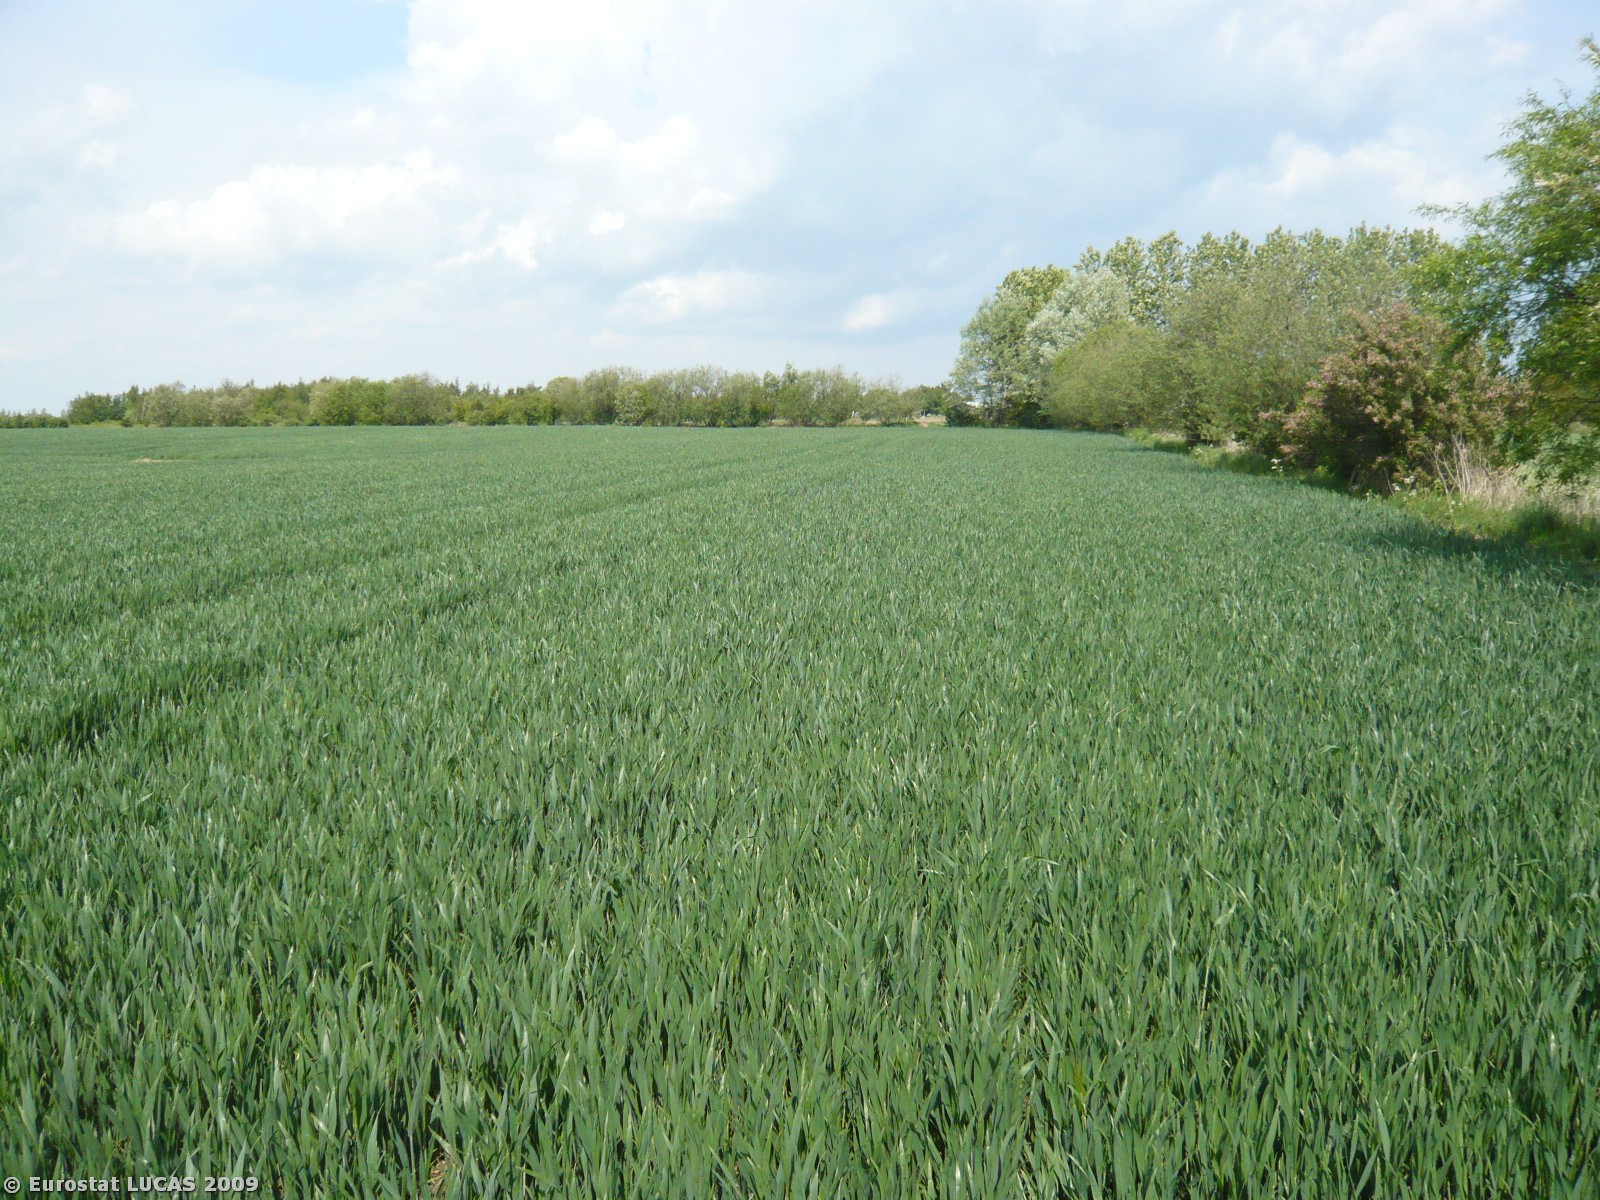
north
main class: Cropland
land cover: Common wheat
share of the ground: > 75 %
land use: Agriculture (excluding fallow land and kitchen gardens)
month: May
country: DK
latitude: 55.3419
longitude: 12.1901
